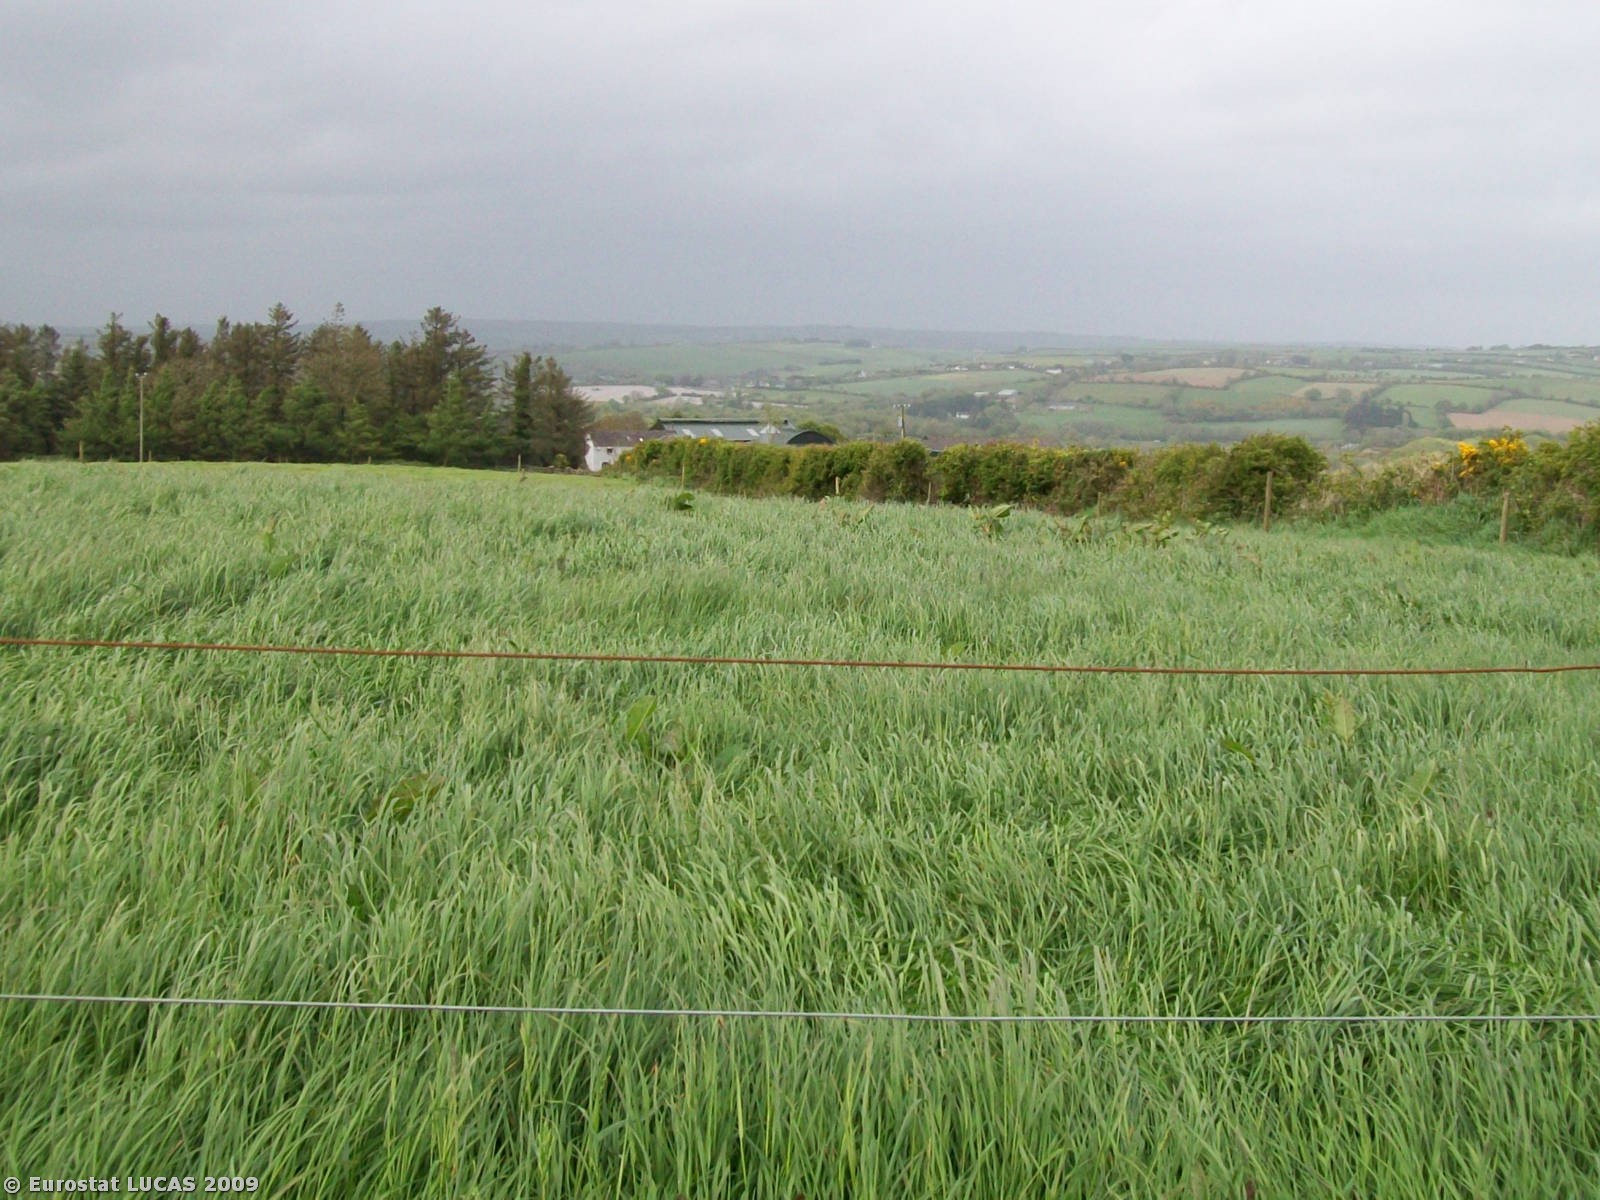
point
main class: Grassland
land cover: Grassland without tree/shrub cover
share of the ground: > 75 %
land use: Agriculture (excluding fallow land and kitchen gardens)
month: May
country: IE
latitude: 51.7456
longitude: -8.6668
